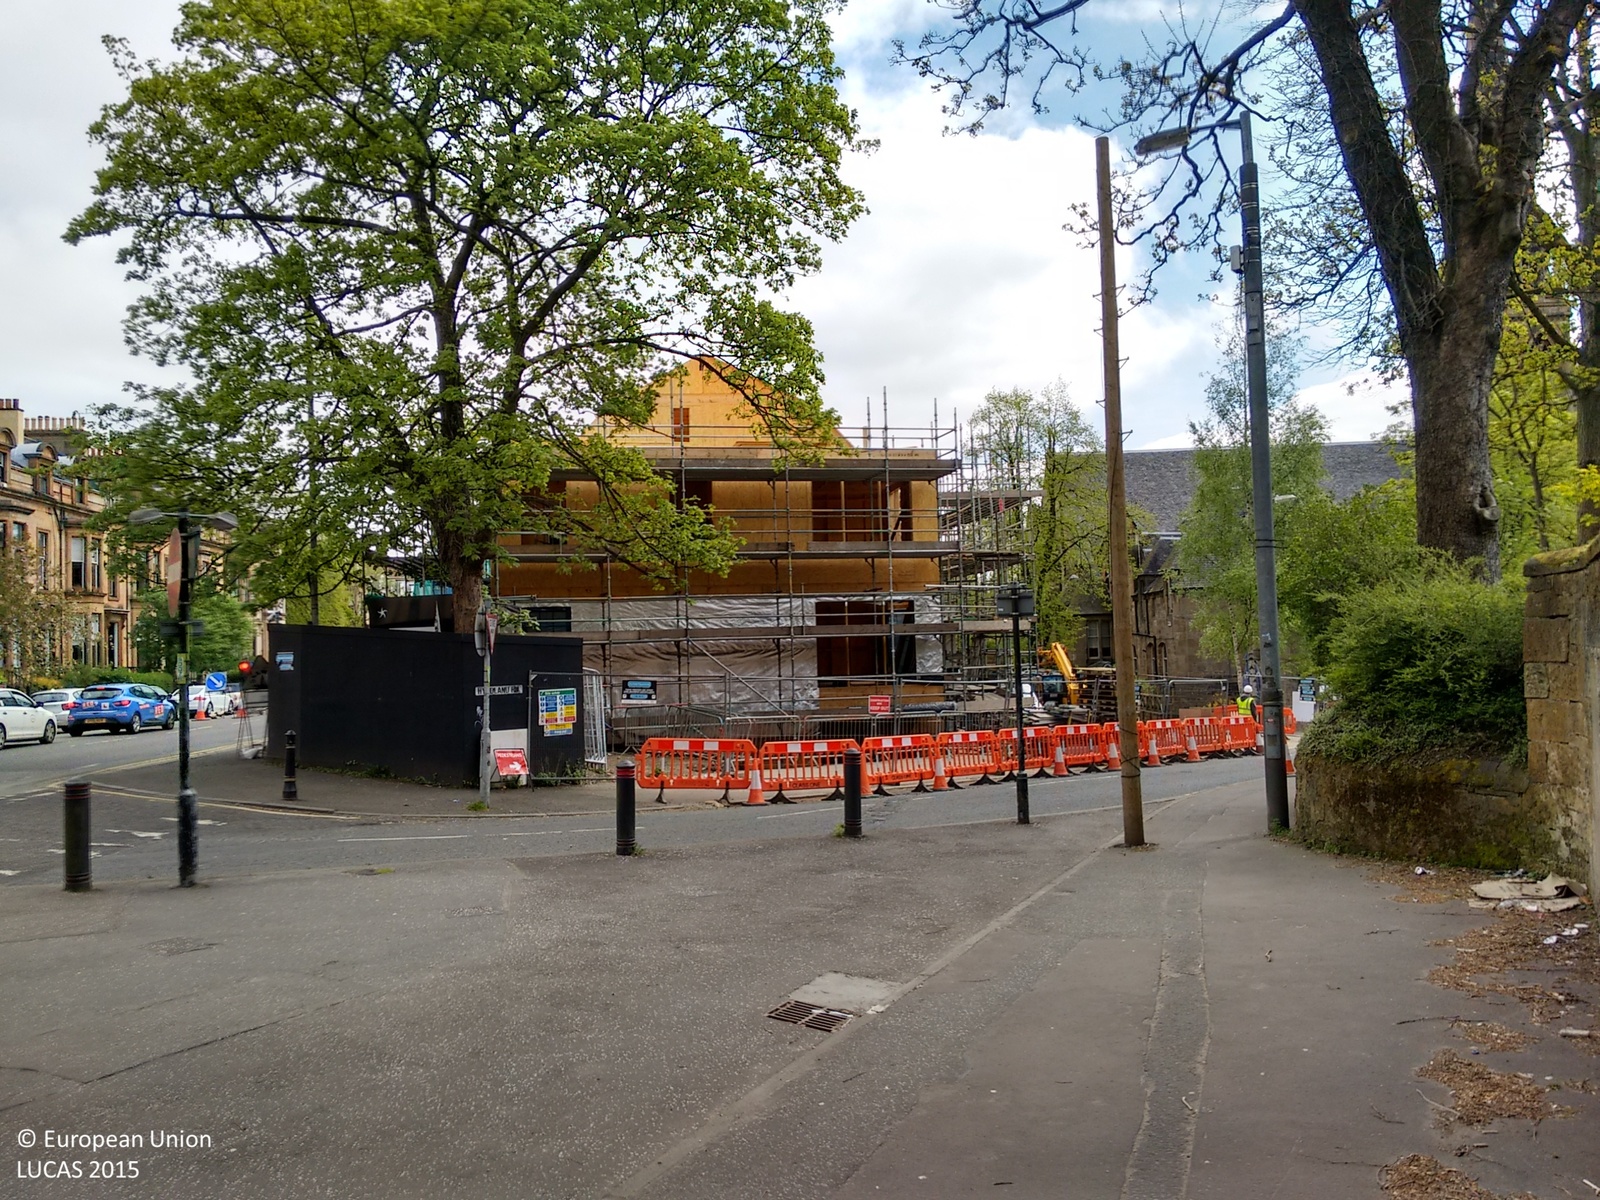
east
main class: Woodland
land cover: Broadleaved woodland
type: exotic forest
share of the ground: > 75 %
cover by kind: broadleaved forest trees 100 %
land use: Residential
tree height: > 5 m
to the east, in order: Broadleaved woodland; Artificial constructions in urban areas
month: May
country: GB
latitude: 55.8746
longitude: -4.3031
